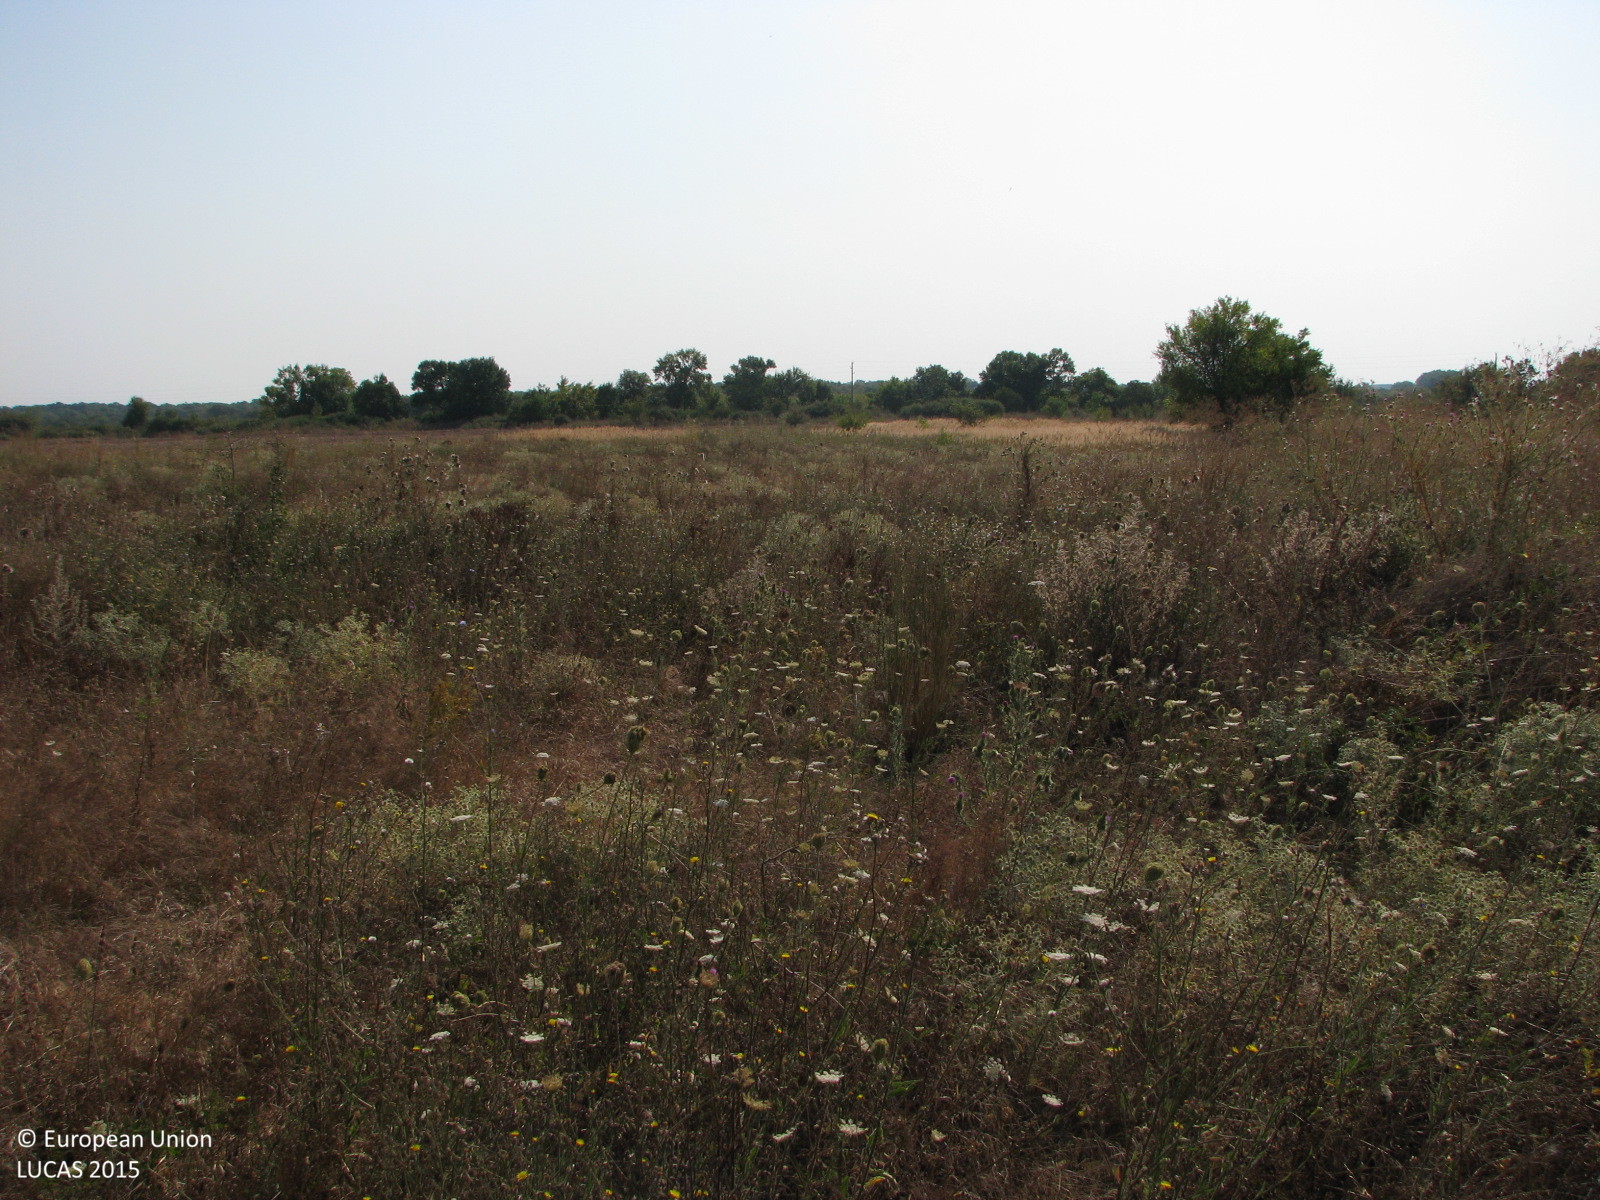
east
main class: Grassland
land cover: Spontaneously vegetated surfaces
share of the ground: > 75 %
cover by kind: herbaceous plants 100 %
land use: Semi-natural and natural areas not in use
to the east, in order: Spontaneously vegetated surfaces; Common wheat; Grassland without tree/shrub cover; Inland fresh running water
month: August
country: BG
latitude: 42.1839
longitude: 26.5436
